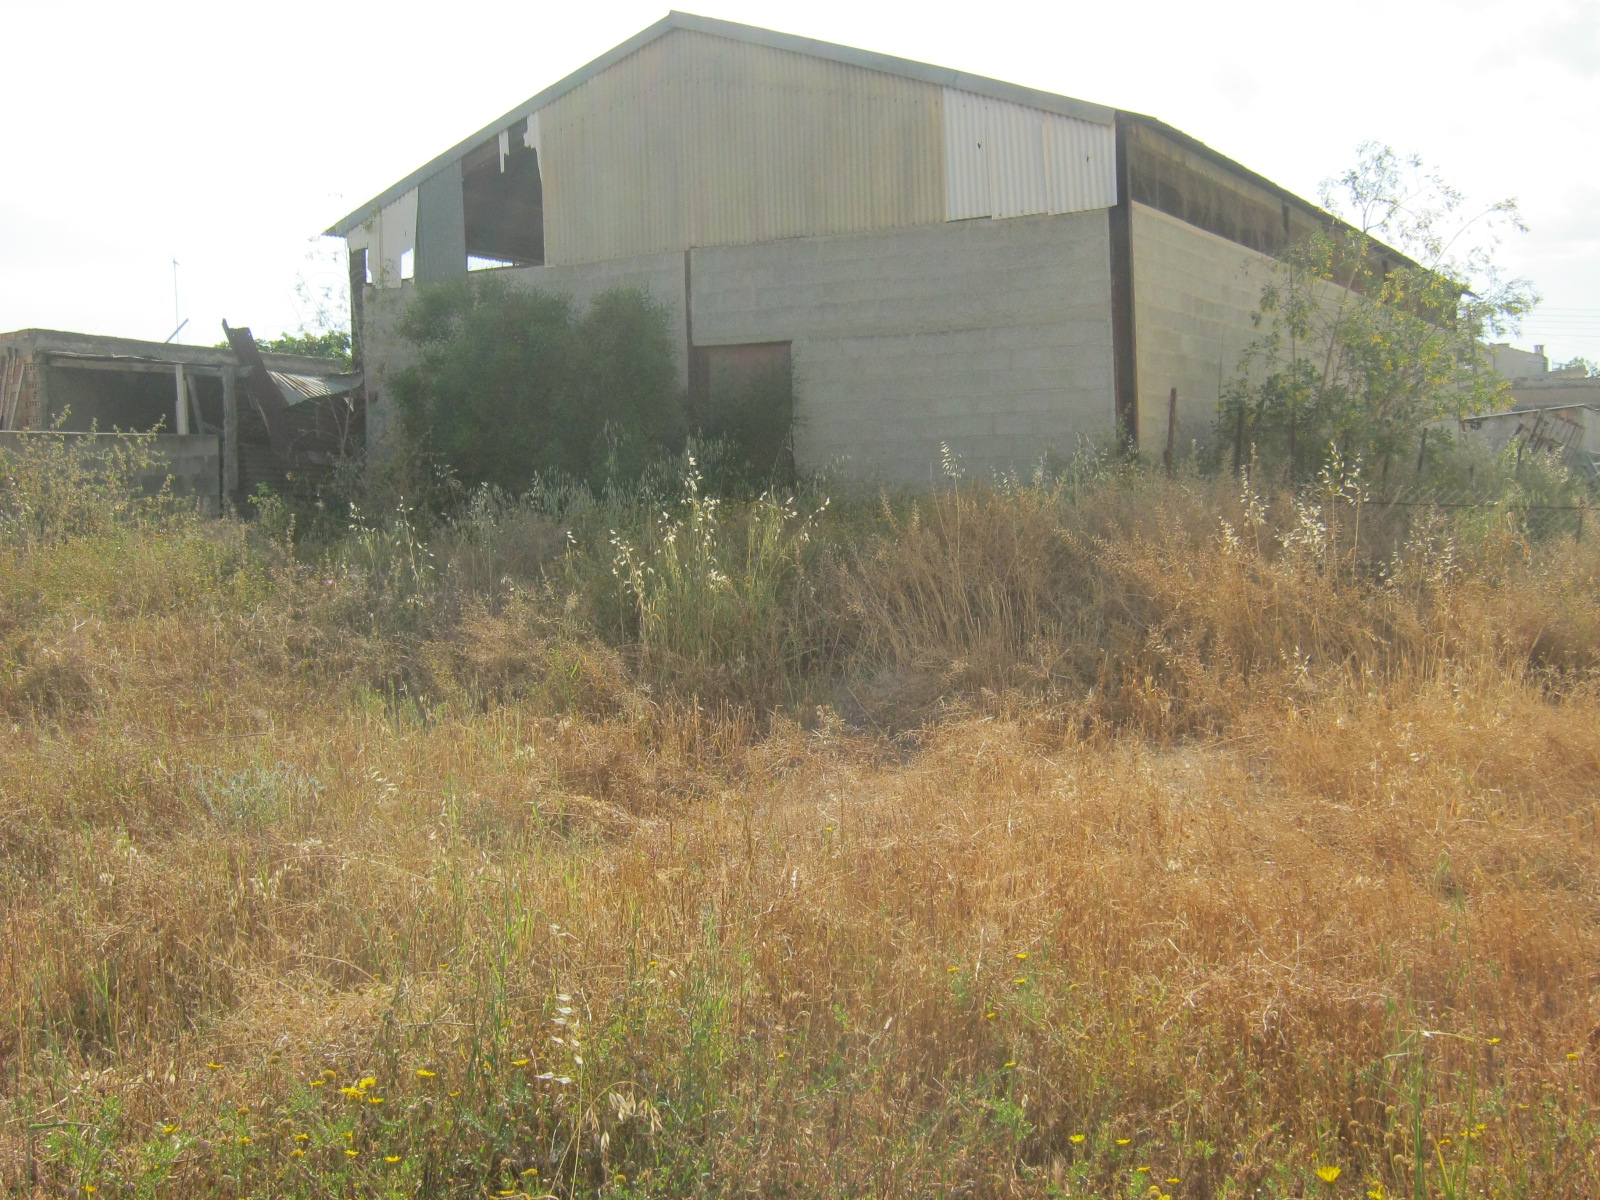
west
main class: Grassland
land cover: Grassland without tree/shrub cover
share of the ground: > 75 %
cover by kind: herbaceous plants 90 %, unconsolidated bare surface 10 %
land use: Residential
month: May
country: CY
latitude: 35.0127
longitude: 33.3888
